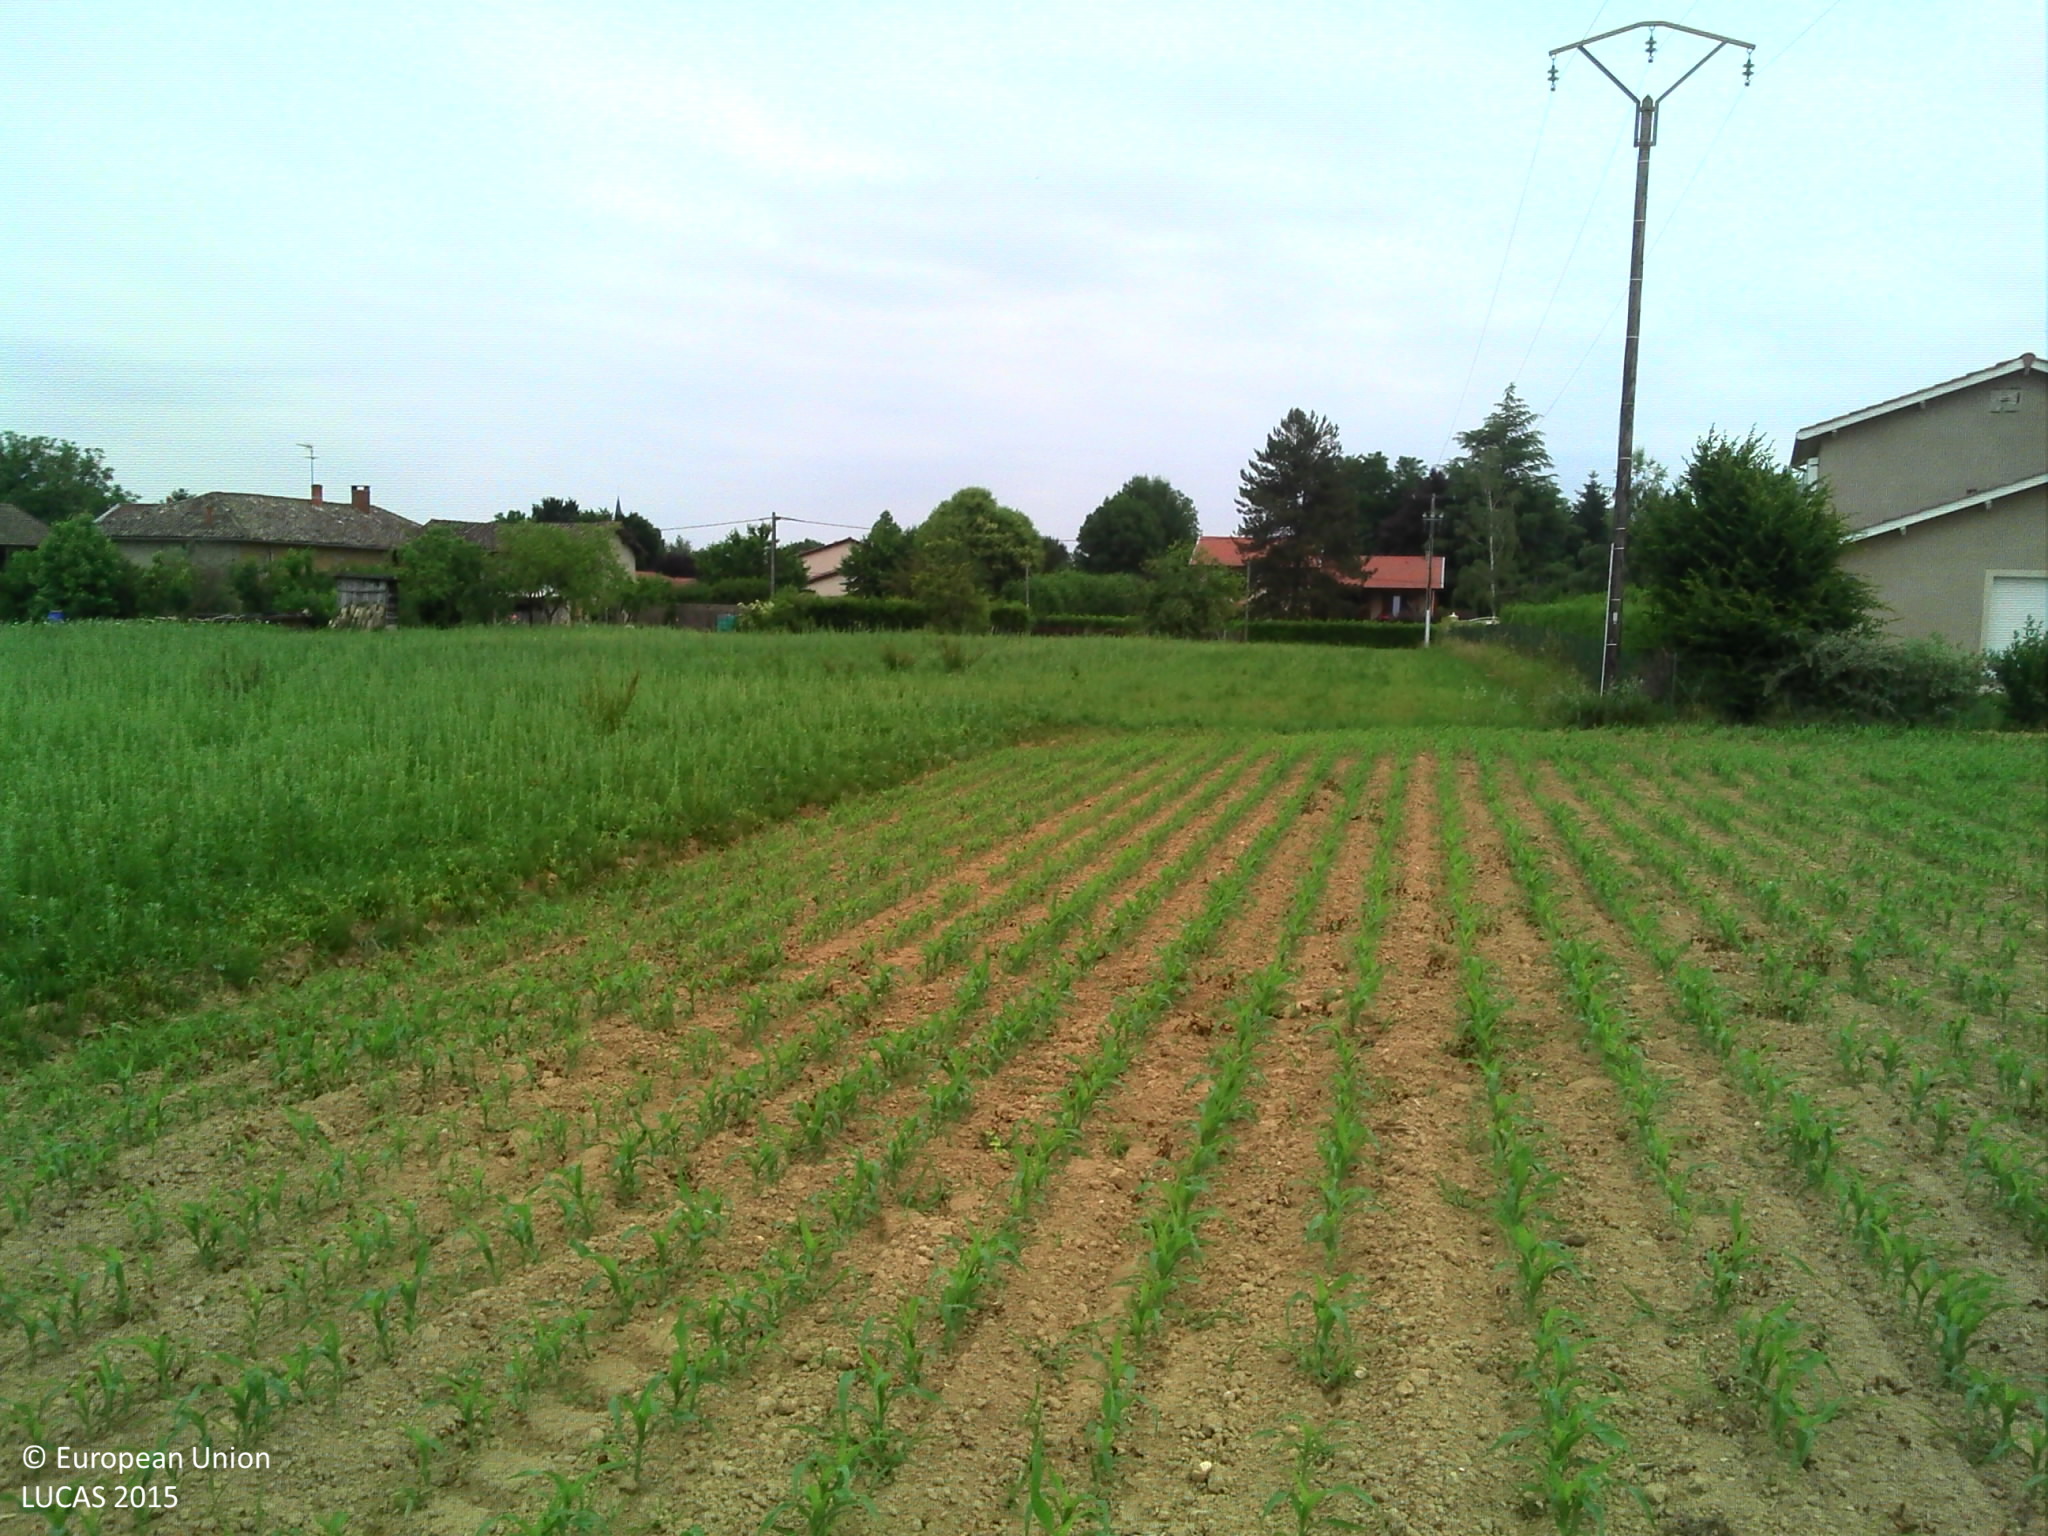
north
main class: Cropland
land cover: Maize
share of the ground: 25 - 50 %
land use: Agriculture (excluding fallow land and kitchen gardens)
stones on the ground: < 10 %
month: June
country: FR
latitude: 46.1351
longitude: 4.8121
